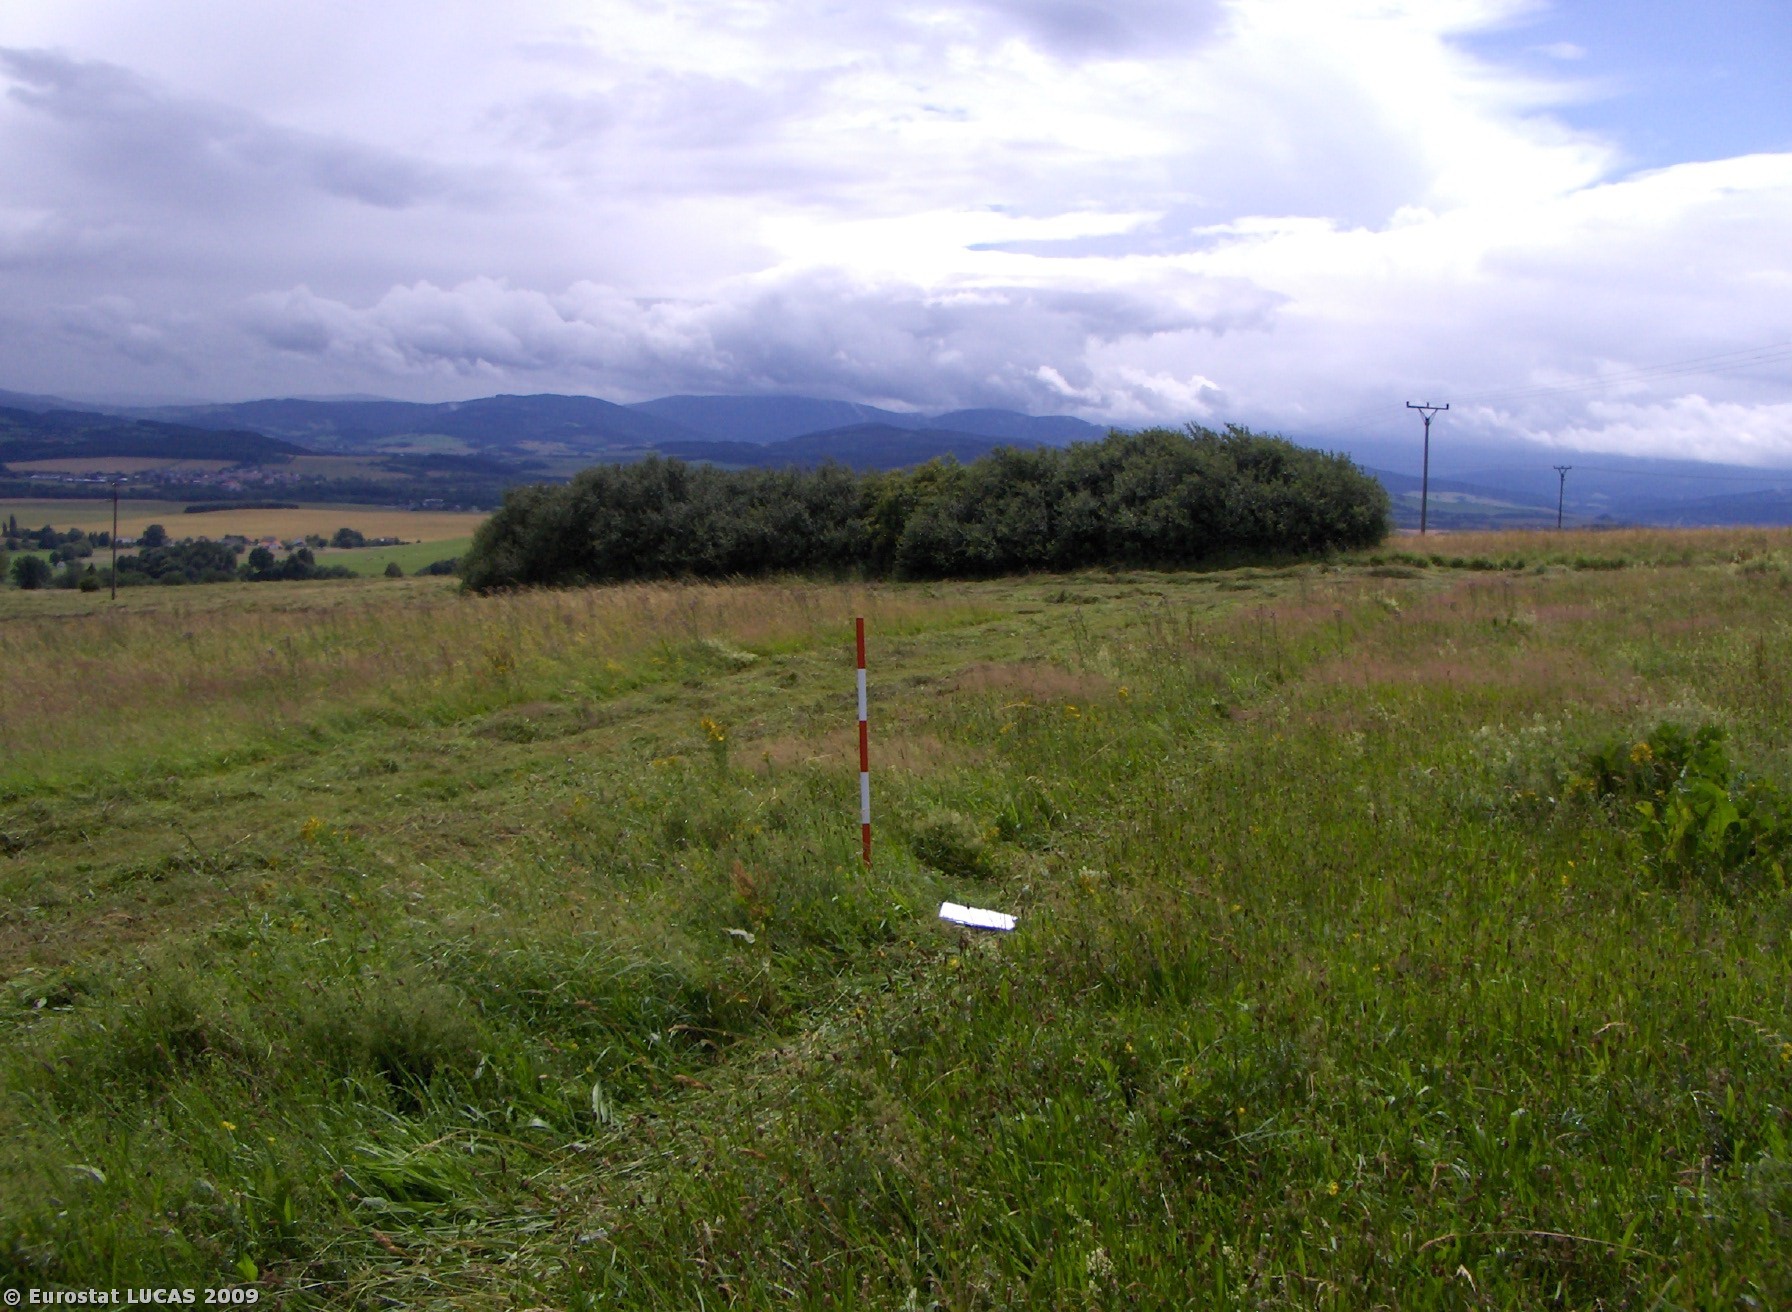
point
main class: Grassland
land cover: Grassland without tree/shrub cover
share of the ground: > 75 %
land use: Agriculture (excluding fallow land and kitchen gardens)
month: July
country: CZ
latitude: 49.3839
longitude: 13.1820
